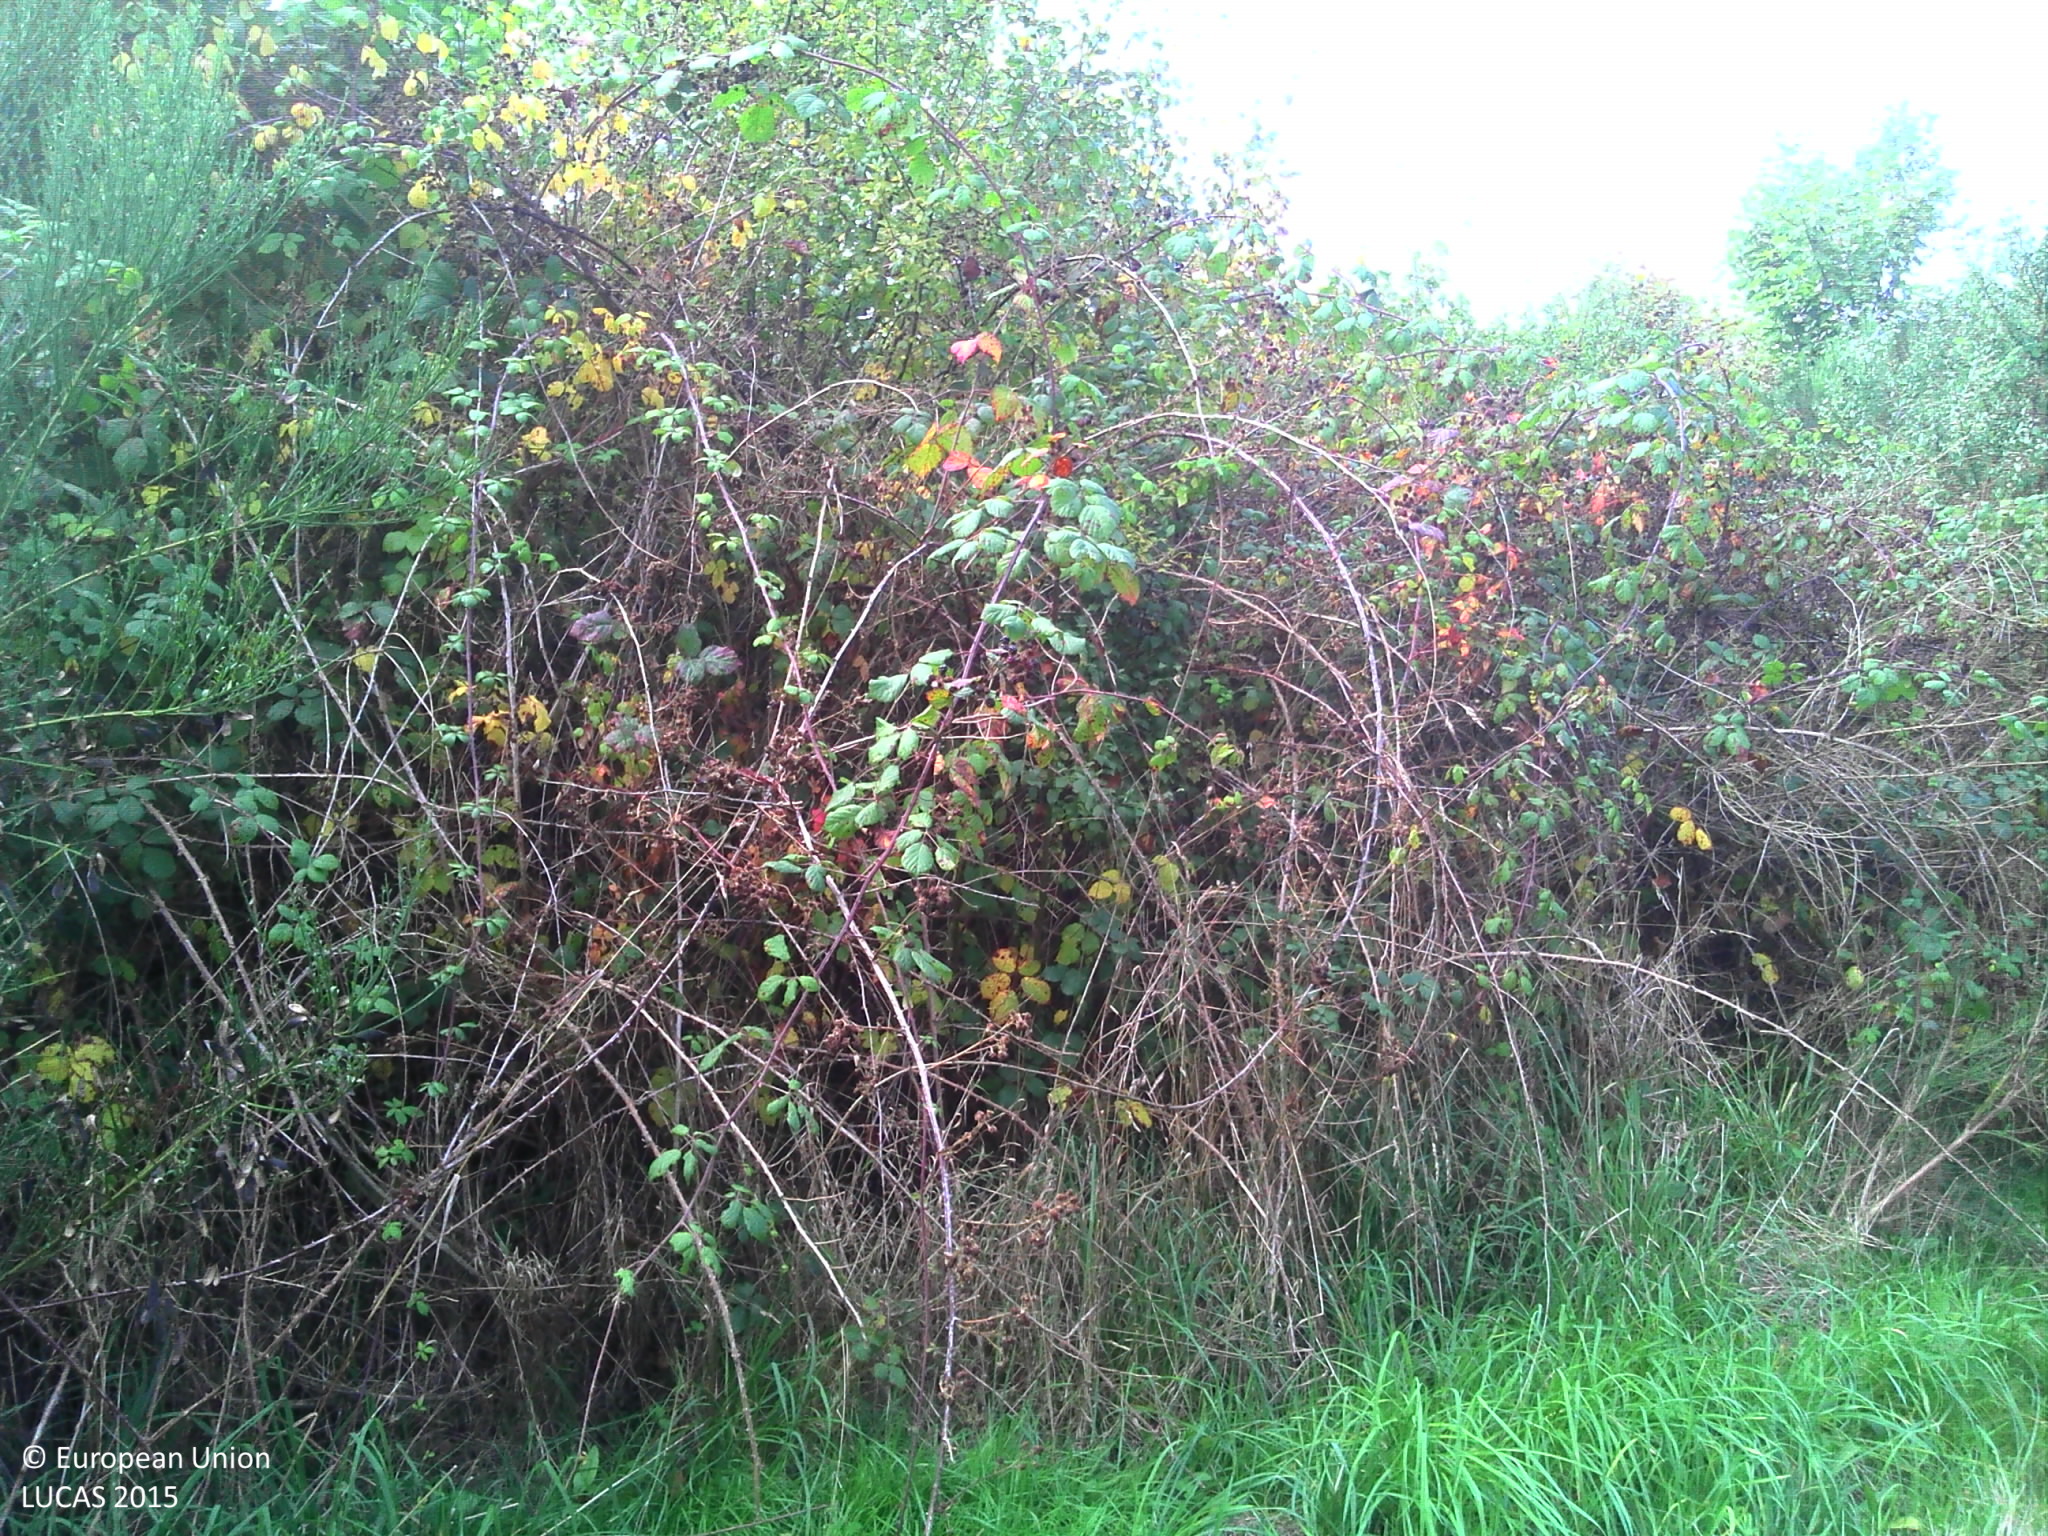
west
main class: Shrubland
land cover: Shrubland without tree cover
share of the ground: > 75 %
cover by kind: shrubs 100 %
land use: Semi-natural and natural areas not in use
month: October
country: FR
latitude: 48.5089
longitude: -3.1347
